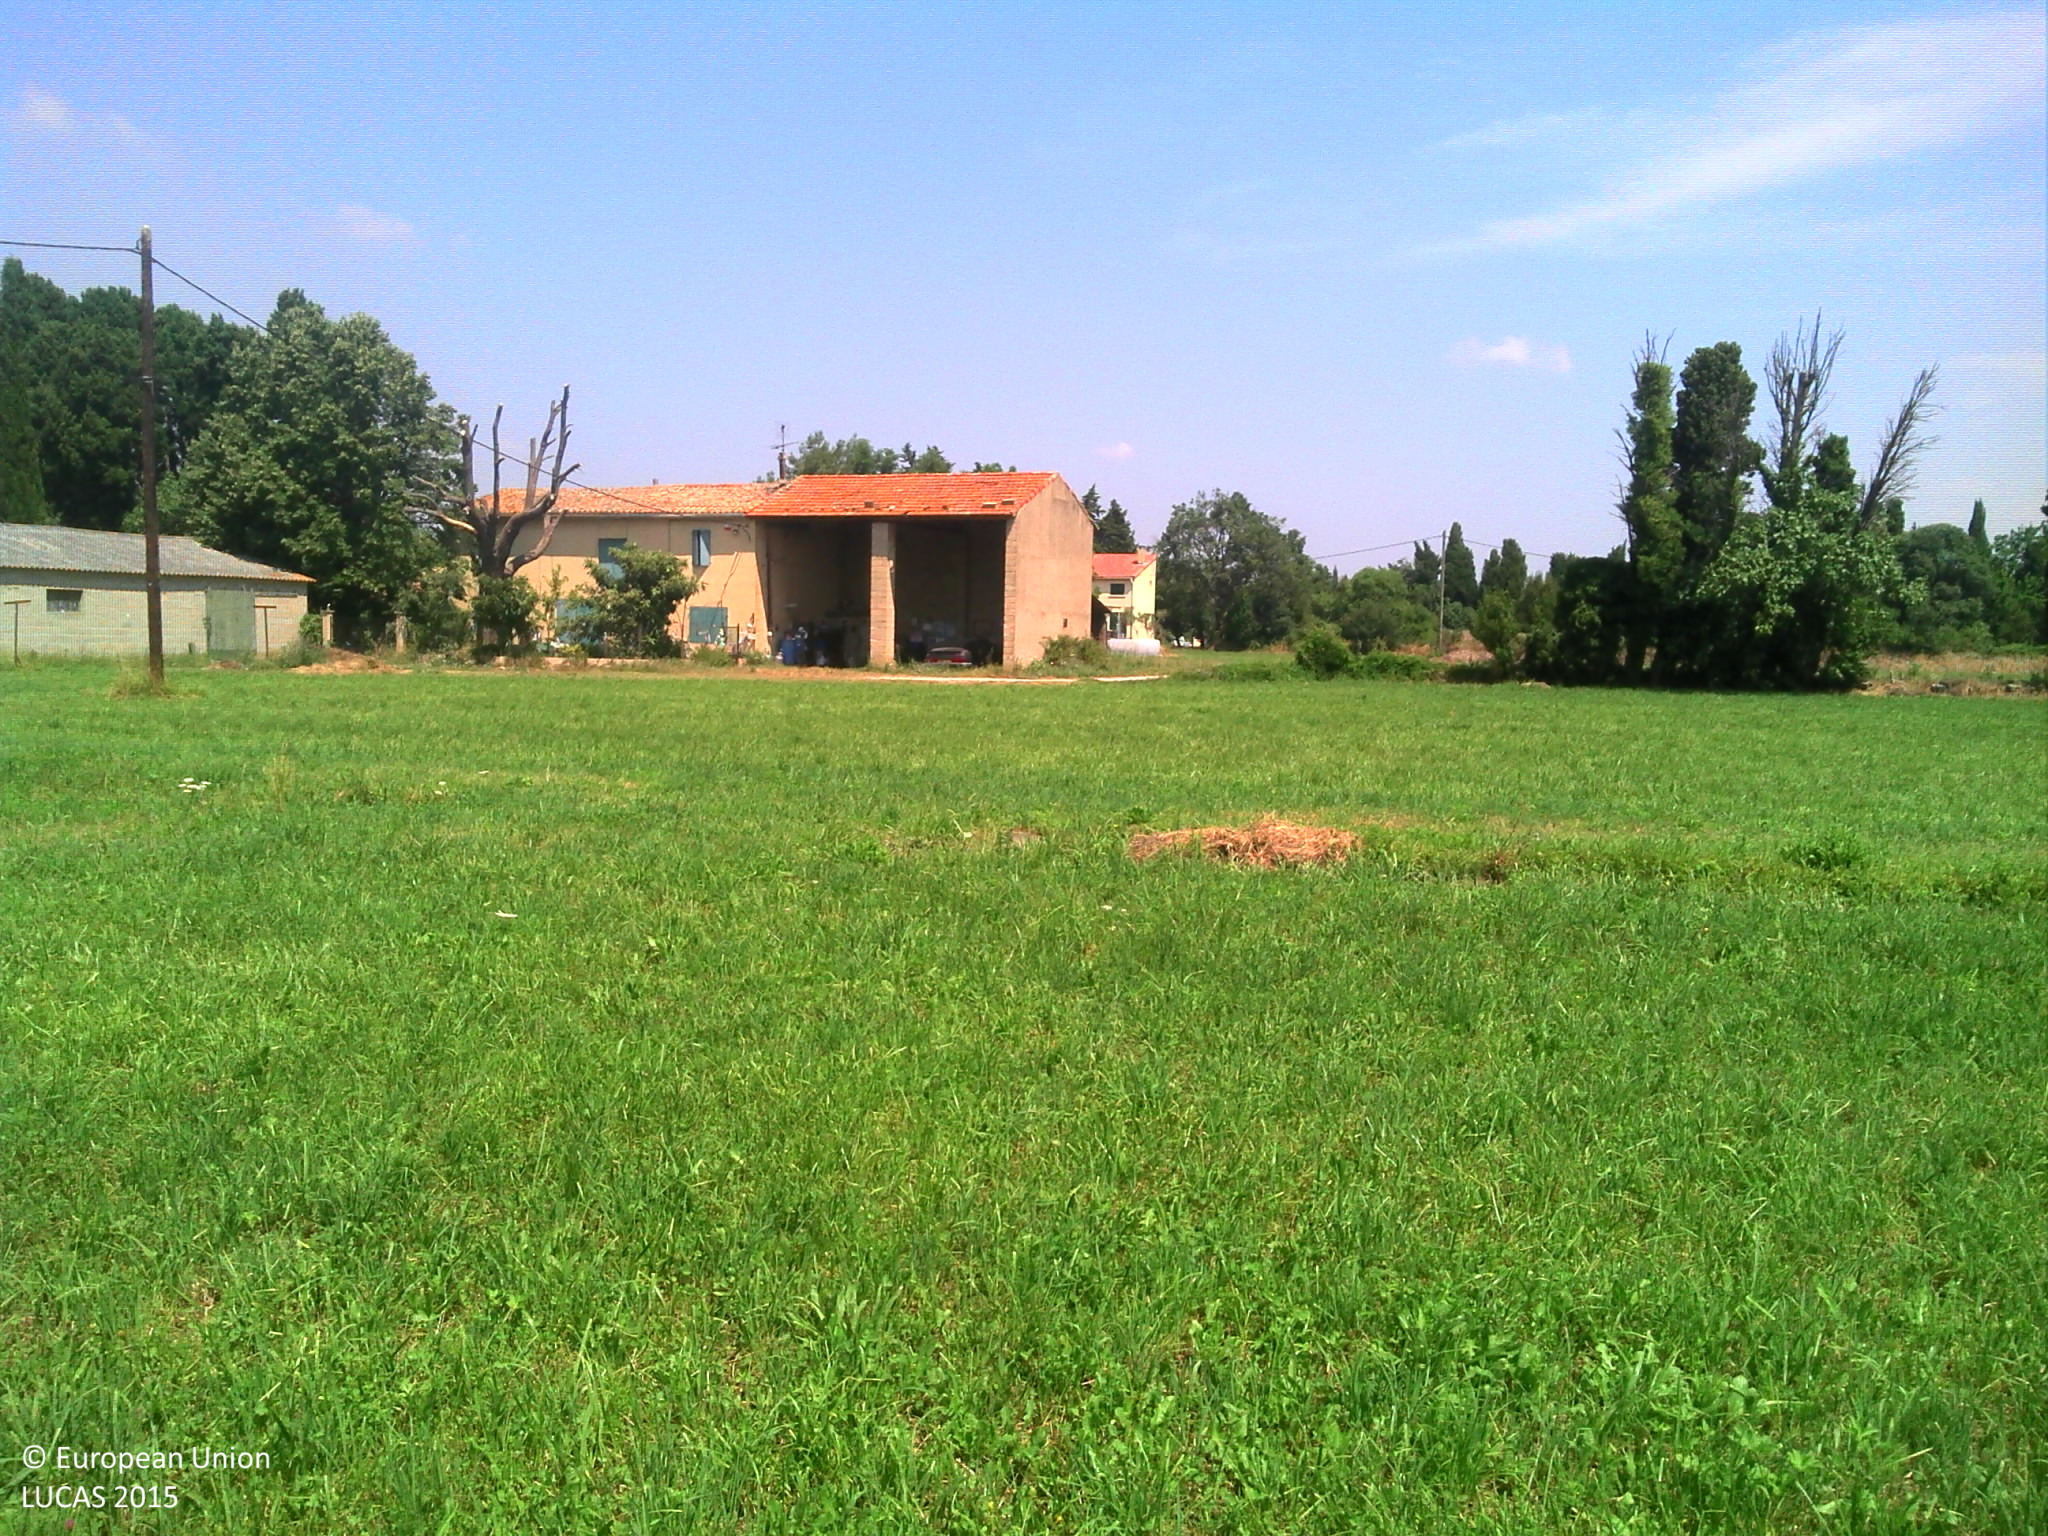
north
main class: Grassland
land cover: Grassland without tree/shrub cover
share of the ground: > 75 %
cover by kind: herbaceous plants 100 %
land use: Agriculture (excluding fallow land and kitchen gardens)
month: July
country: FR
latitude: 43.6367
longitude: 5.0637
